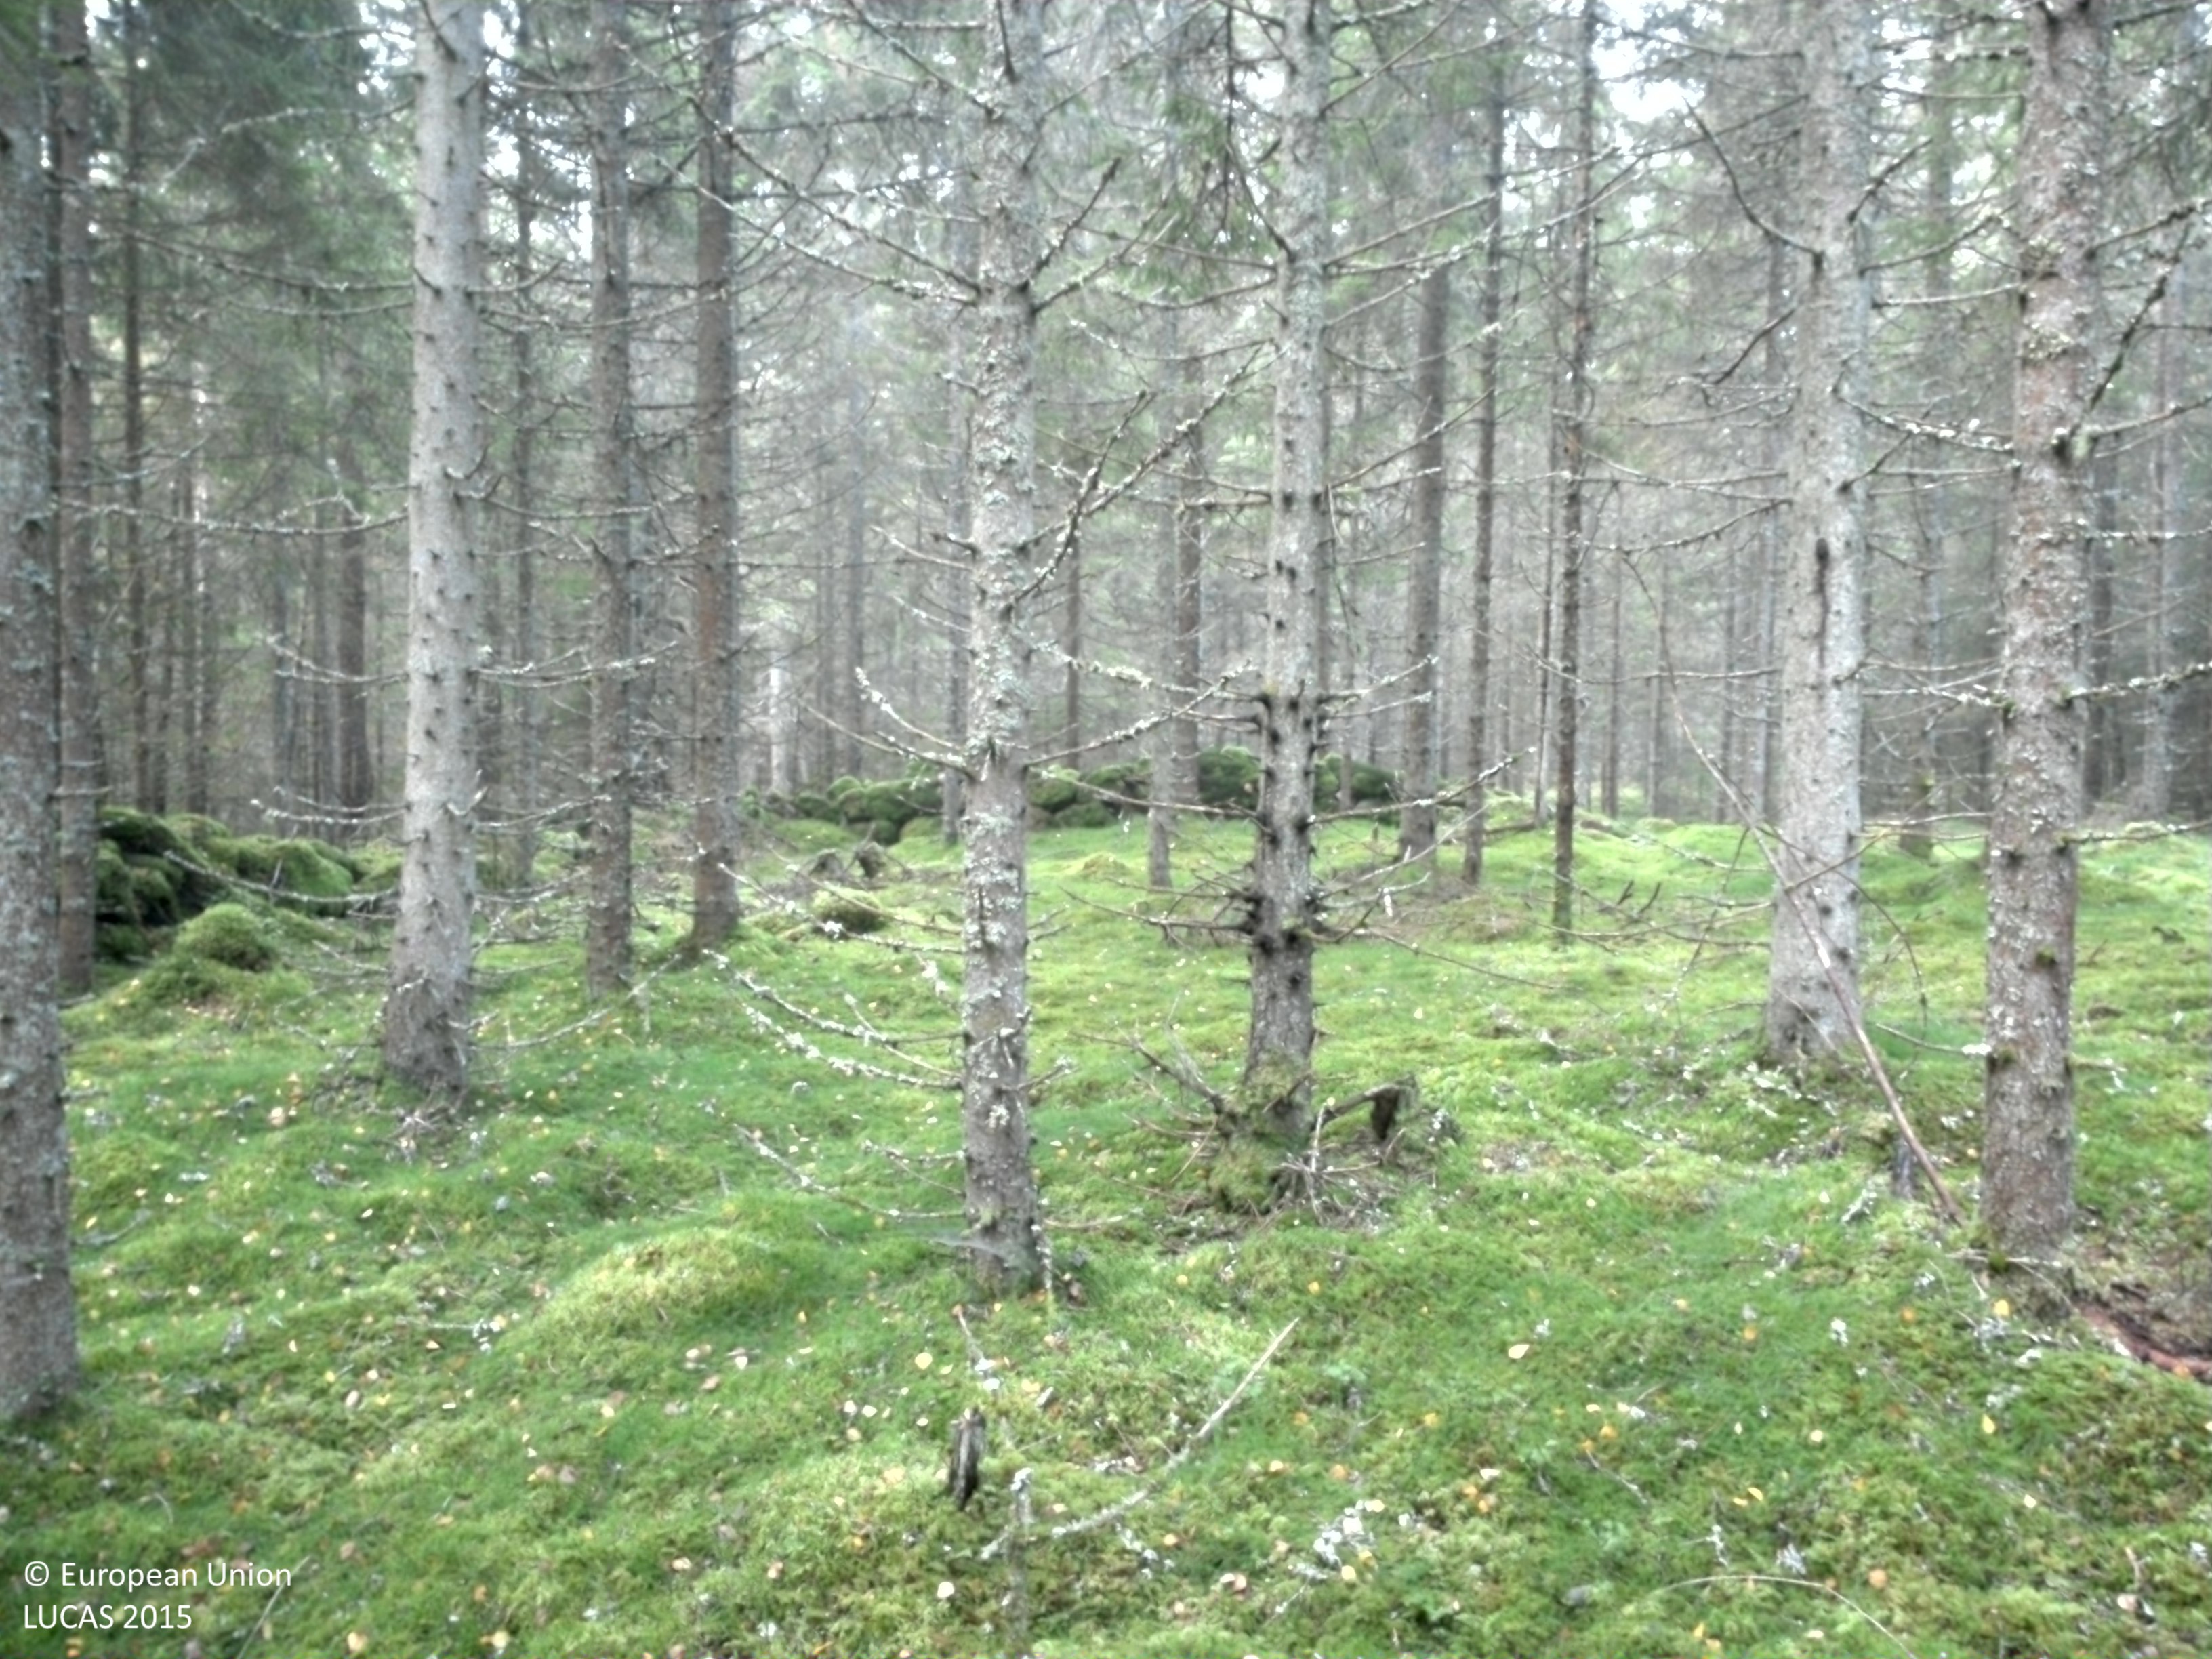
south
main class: Woodland
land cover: Spruce dominated coniferous woodland
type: boreal forest
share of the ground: > 75 %
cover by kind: coniferous forest trees 75 %, lichens and mosses 25 %
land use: Forestry
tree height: > 5 m
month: September
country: SE
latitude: 57.8743
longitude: 13.2491
